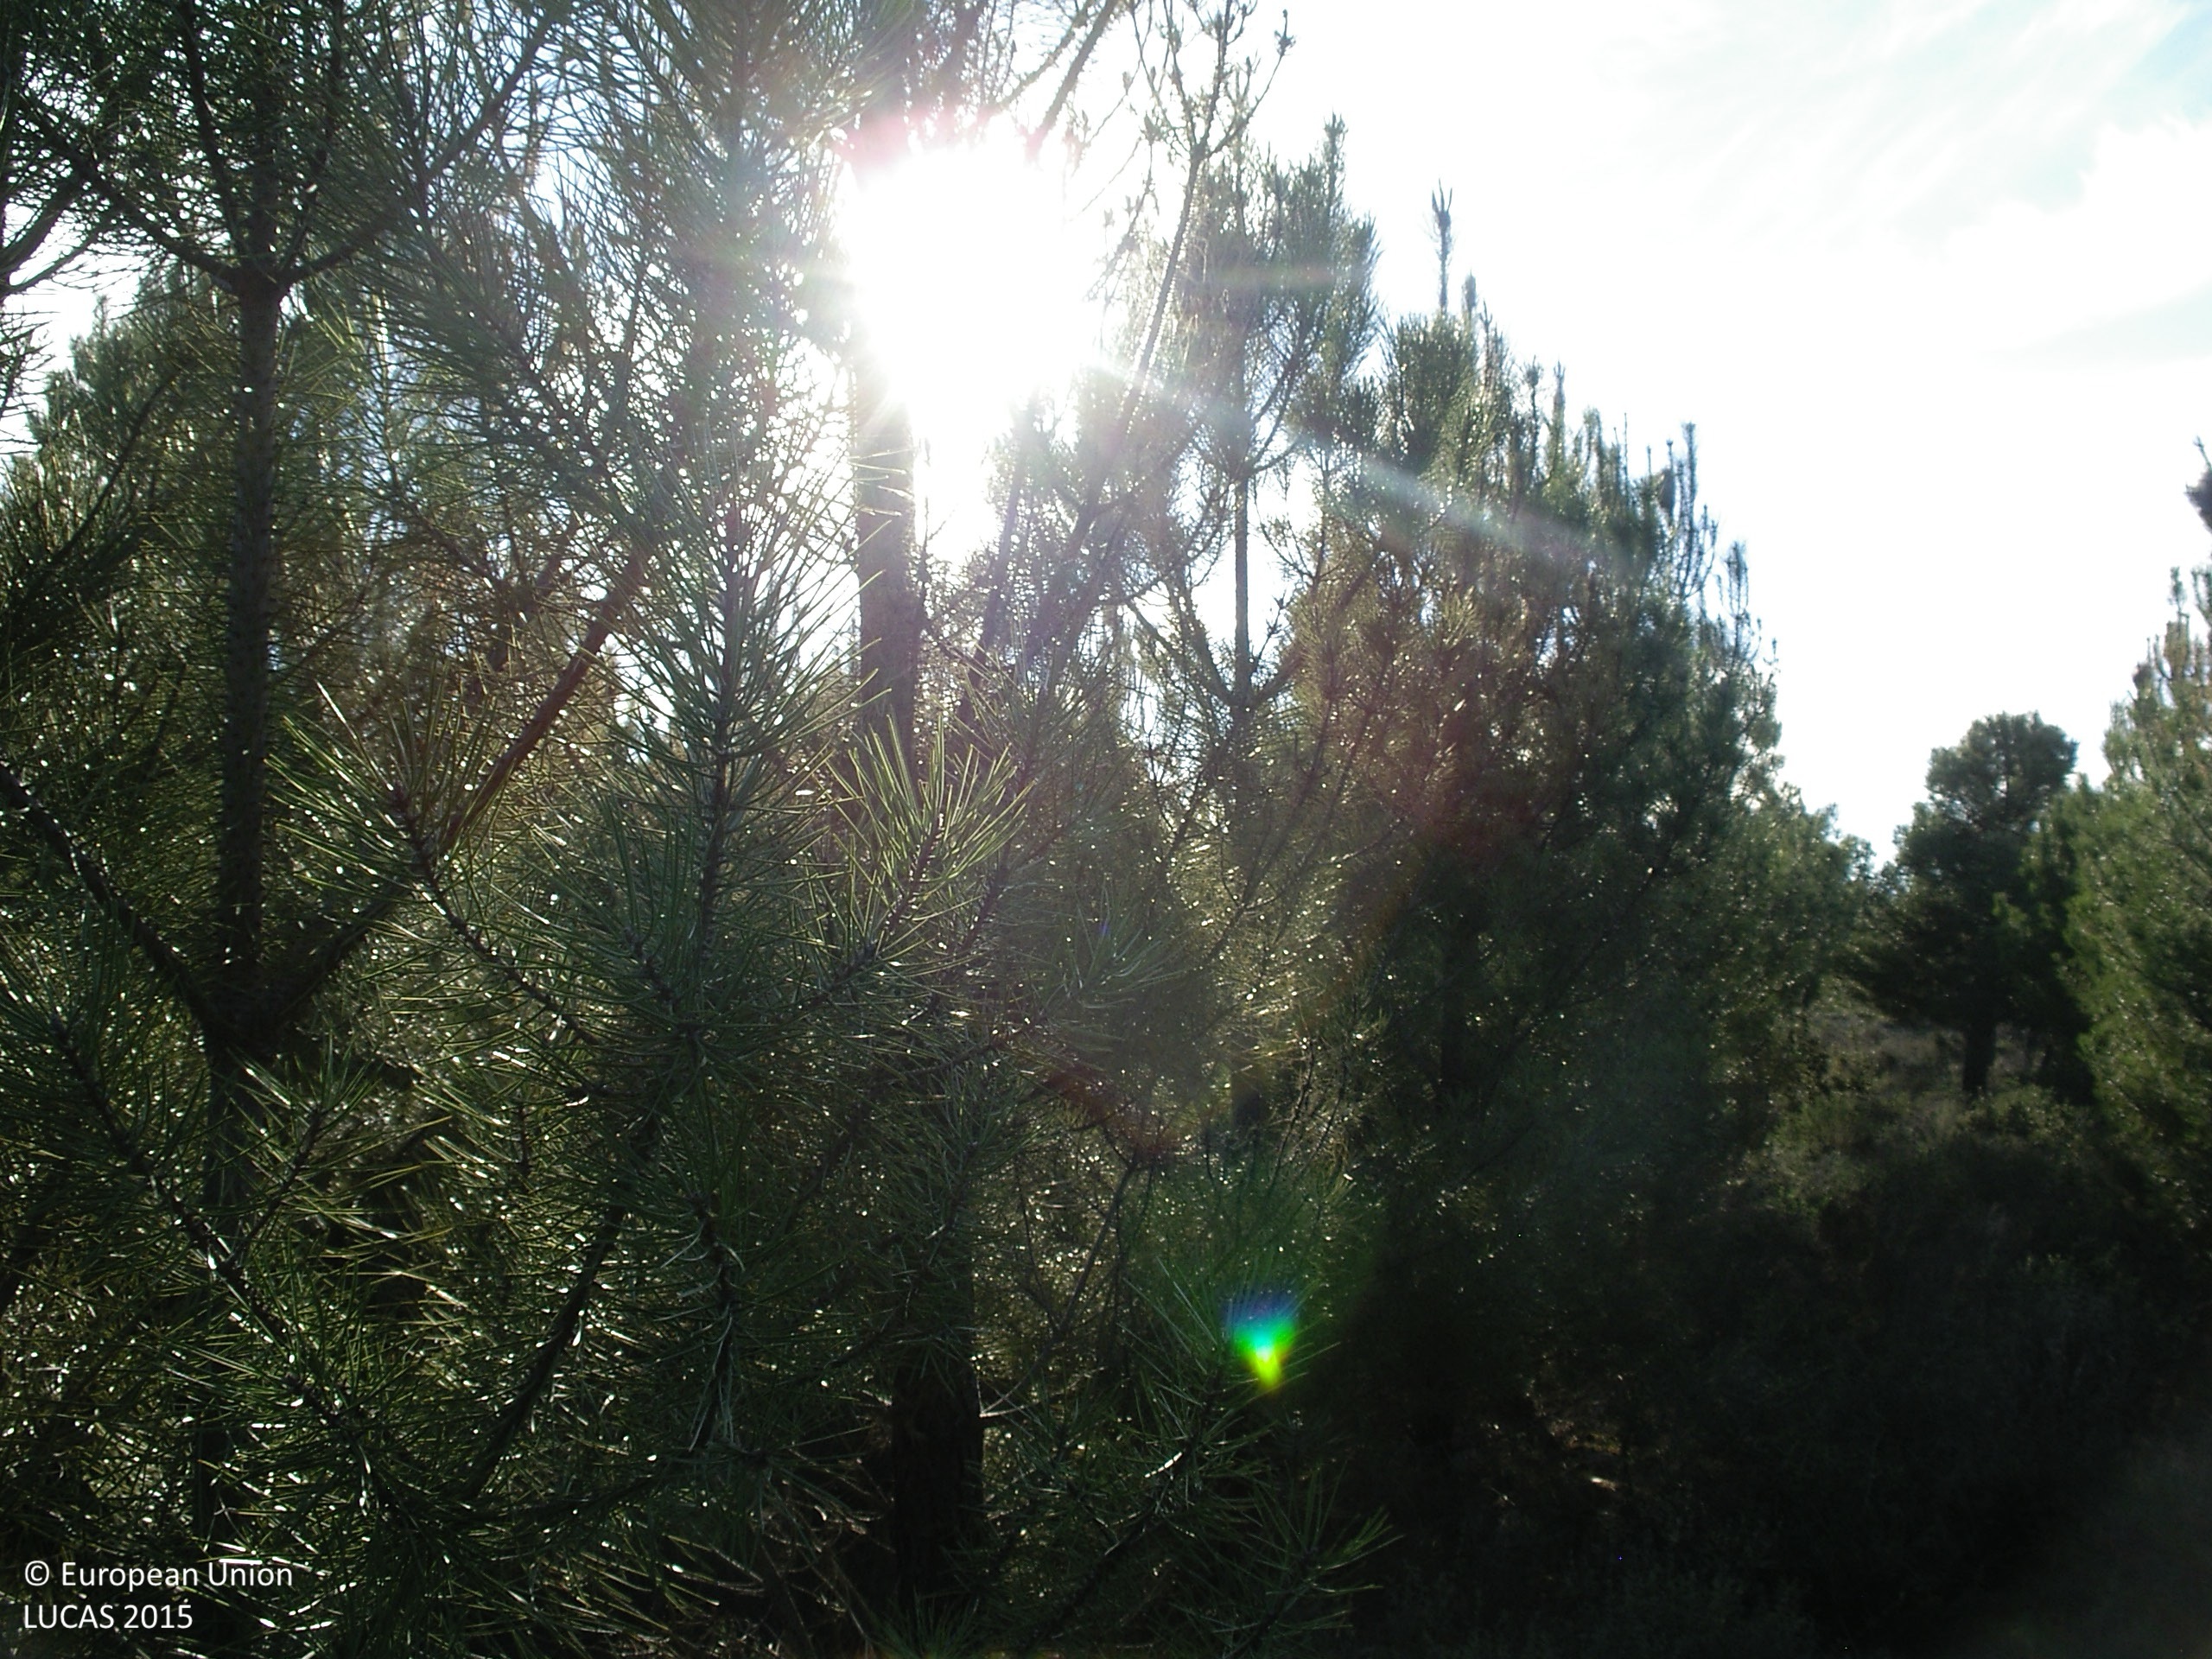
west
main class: Woodland
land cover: Pine dominated coniferous woodland
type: coniferous forest of the mediterranean region
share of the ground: > 75 %
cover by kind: coniferous forest trees 90 %, shrubs 10 %
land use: Forestry
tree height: > 5 m
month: March
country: ES
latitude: 42.2969
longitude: -6.0786
